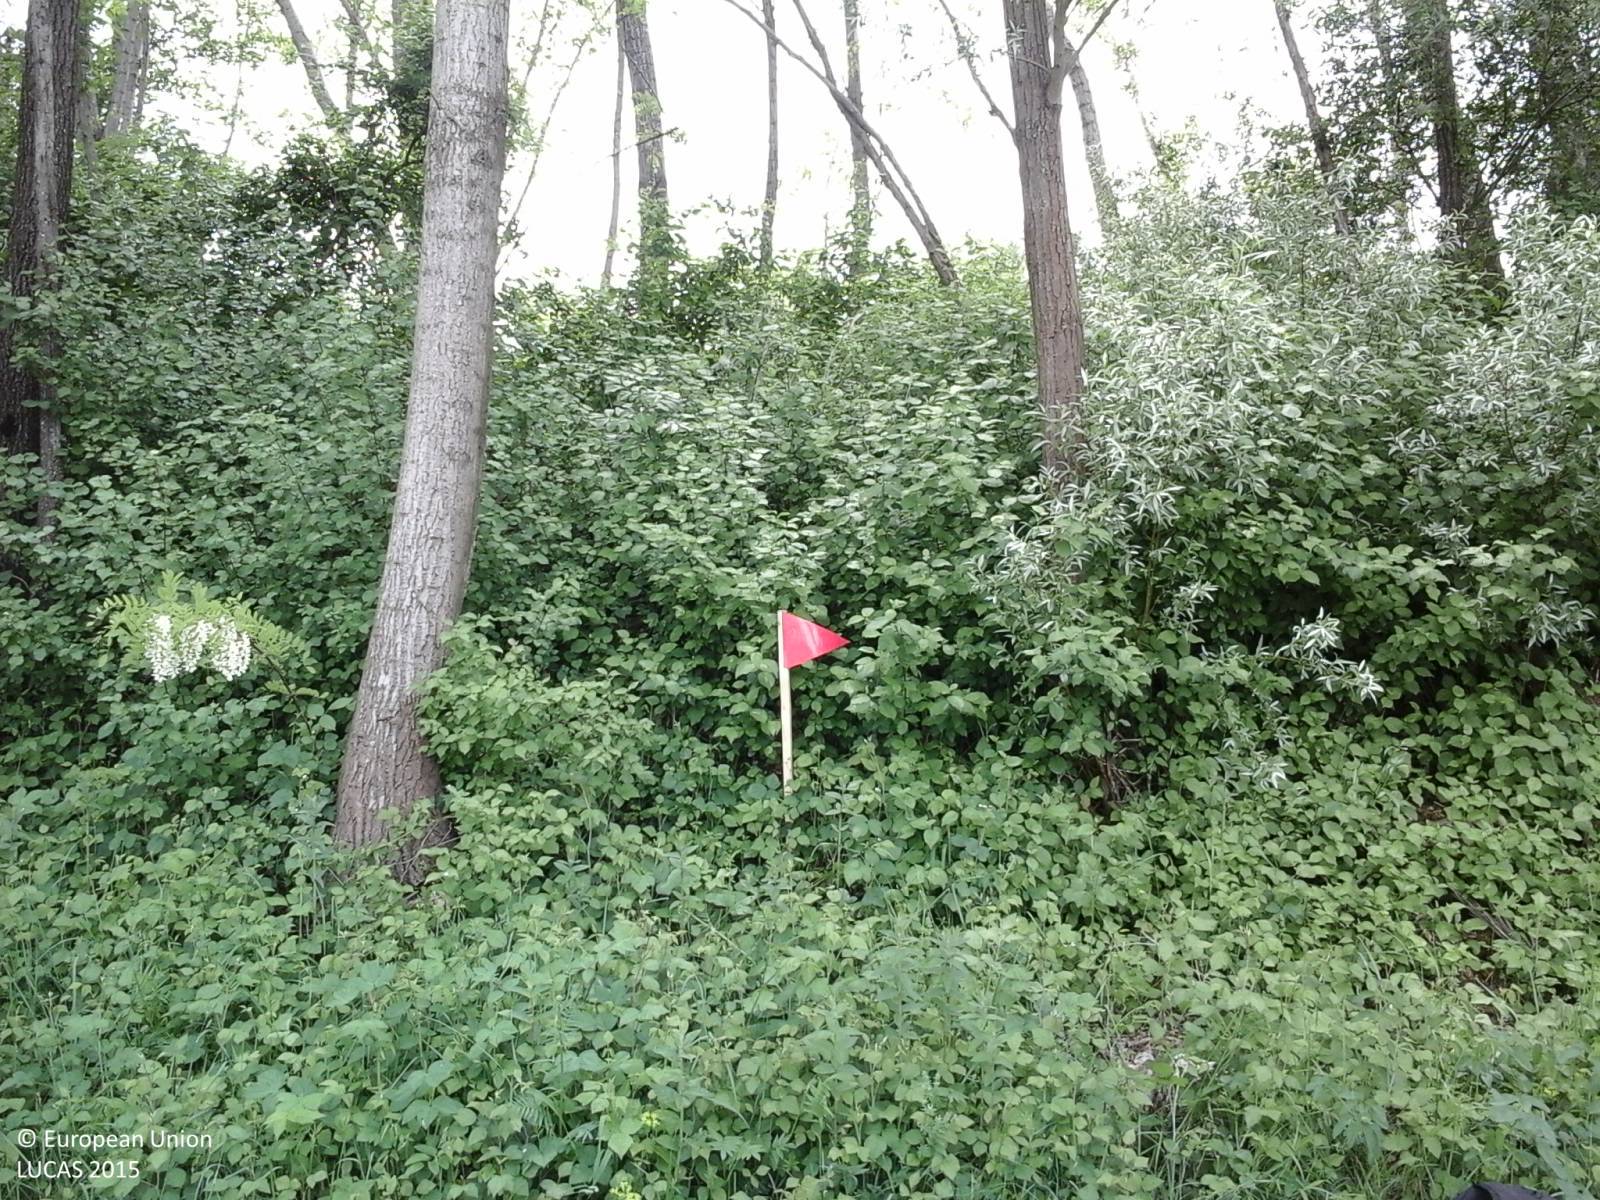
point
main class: Woodland
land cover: Broadleaved woodland
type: floodplain forest
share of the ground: > 75 %
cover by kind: broadleaved forest trees 80 %, shrubs 20 %
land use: Forestry
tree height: > 5 m
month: May
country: IT
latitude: 46.1991
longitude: 13.0679
